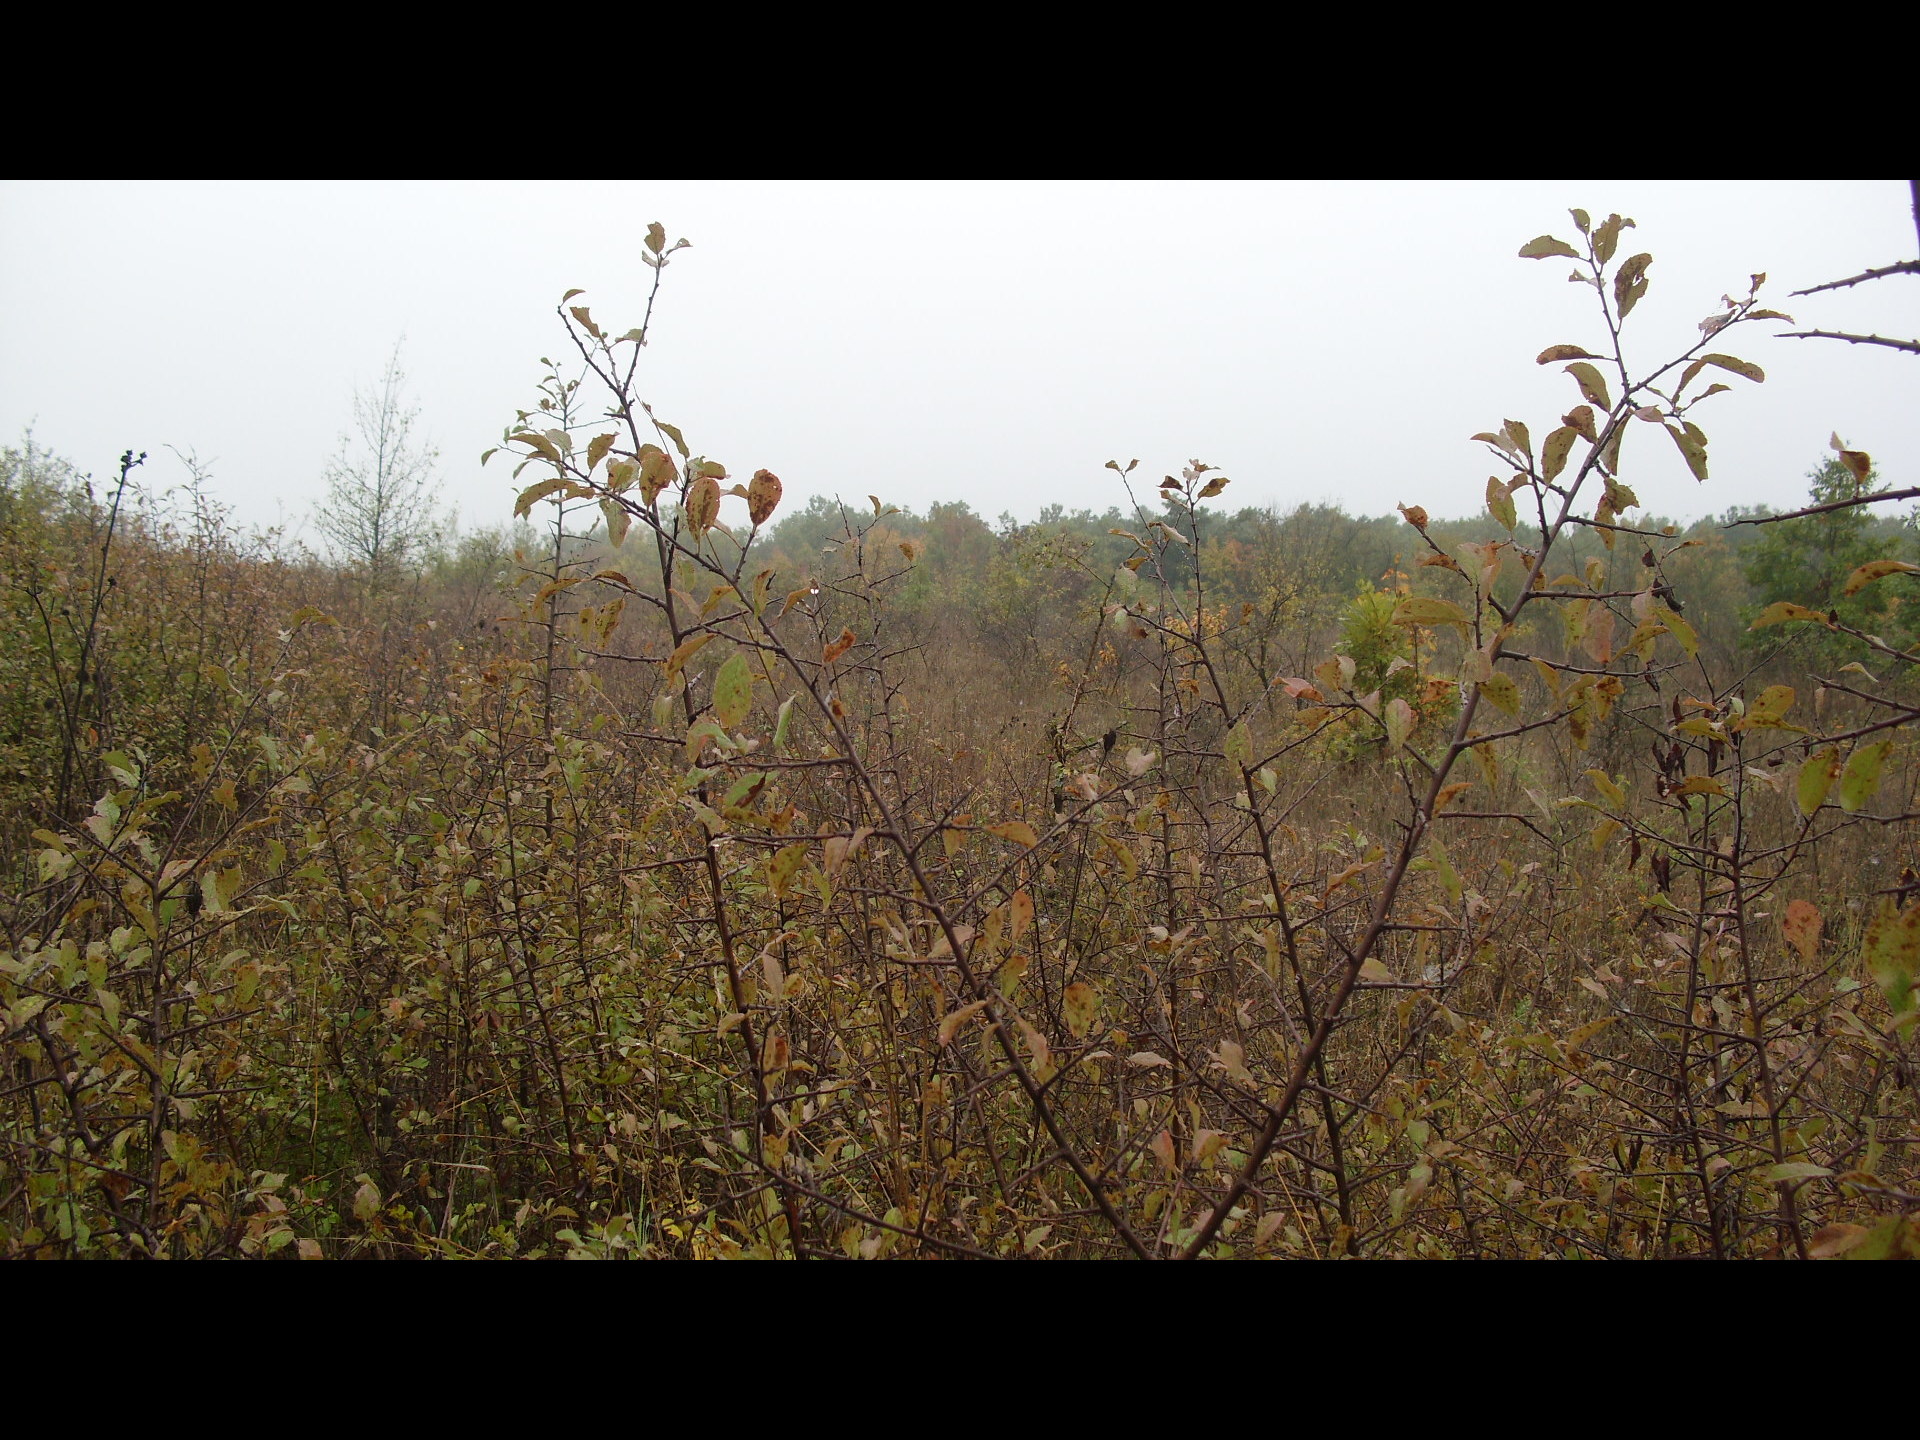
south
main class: Shrubland
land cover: Shrubland with sparse tree cover
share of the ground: > 75 %
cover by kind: shrubs 95 %, broadleaved forest trees 5 %
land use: Semi-natural and natural areas not in use
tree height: < 5 m
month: October
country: BG
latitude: 43.7300
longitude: 22.5595
